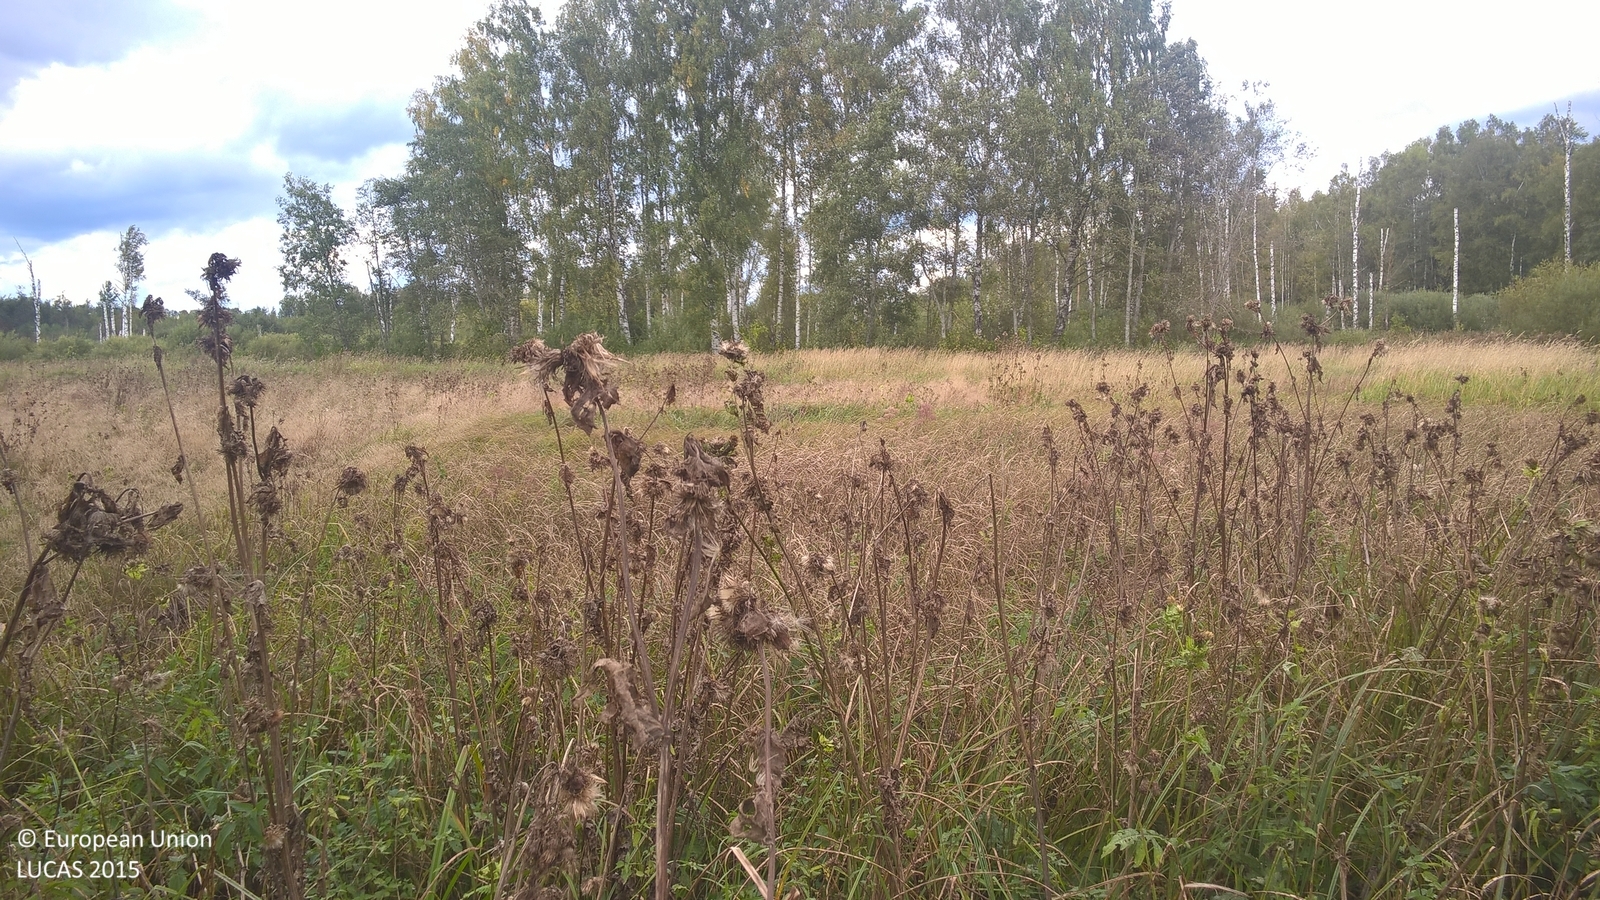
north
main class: Grassland
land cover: Spontaneously vegetated surfaces
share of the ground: > 75 %
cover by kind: herbaceous plants 95 %, shrubs 5 %
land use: Semi-natural and natural areas not in use
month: September
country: LV
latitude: 57.7172
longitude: 25.6456
